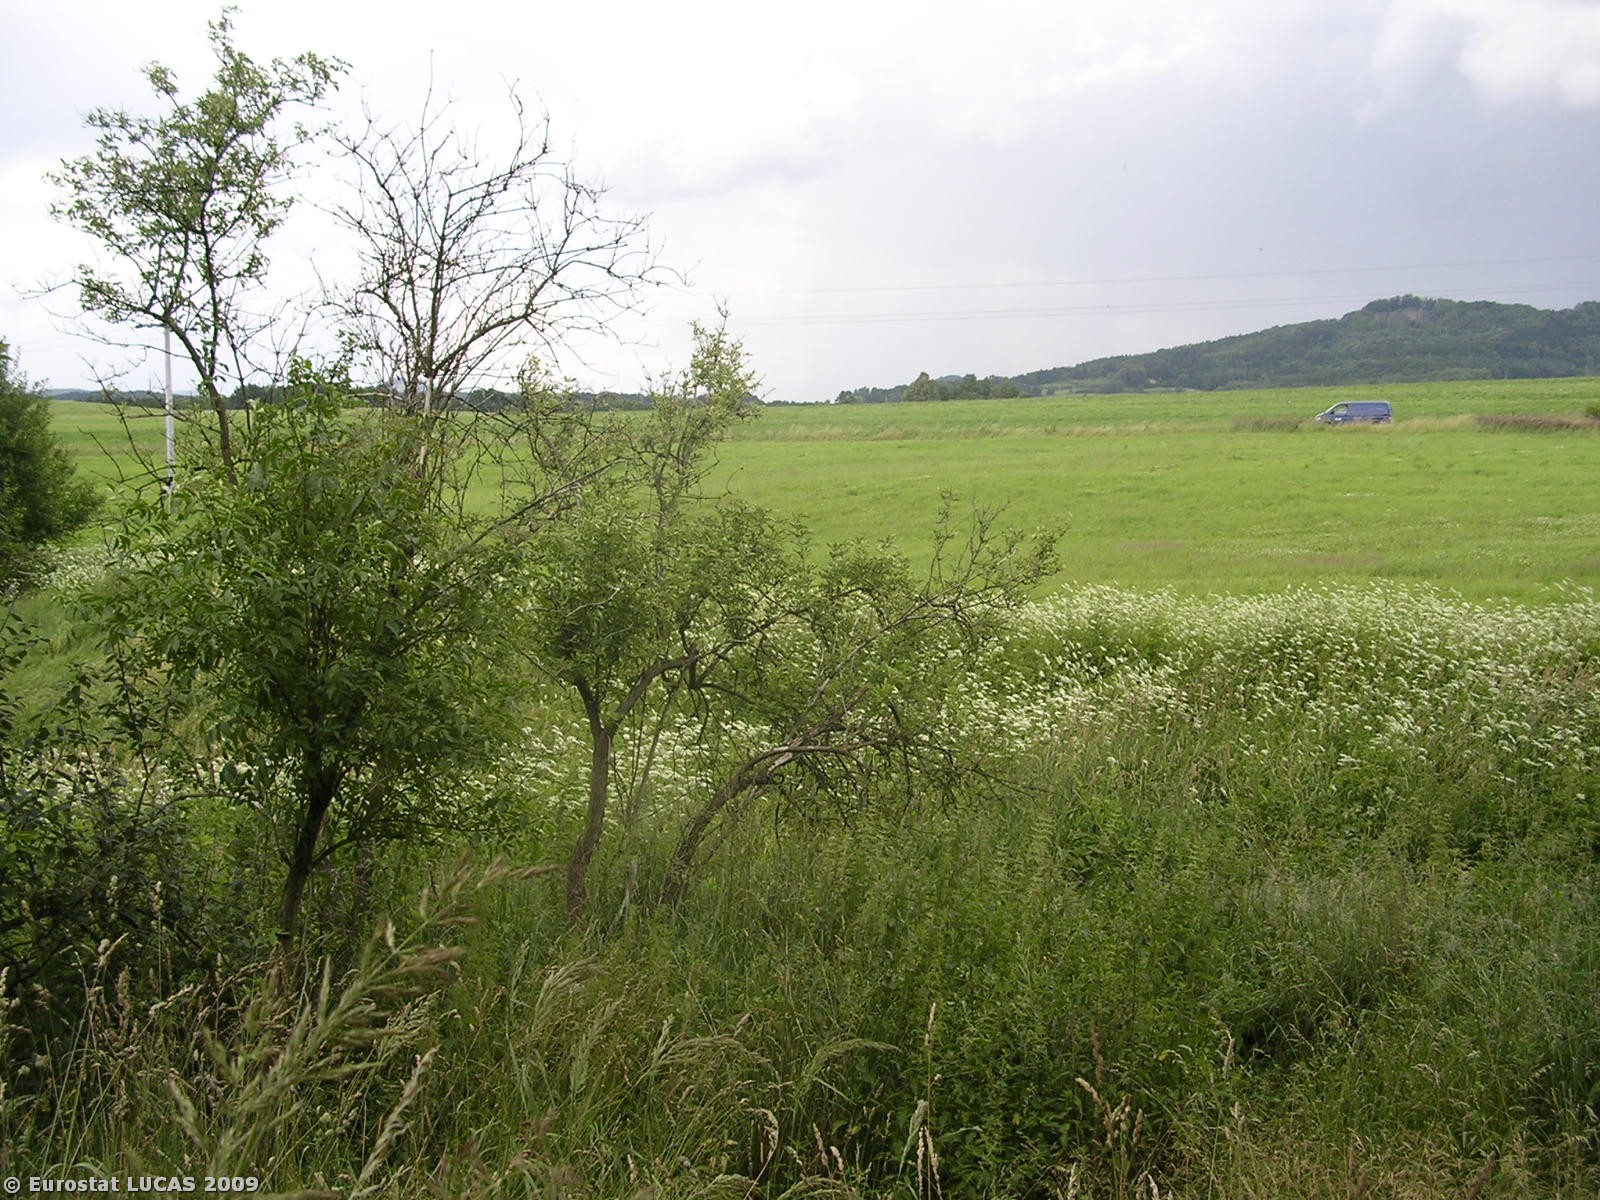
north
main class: Woodland
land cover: Broadleaved woodland
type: acidophilous oak and oak-birch forest
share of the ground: 50 - 75 %
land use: Forestry
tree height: > 5 m
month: July
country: CZ
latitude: 50.6655
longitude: 14.6568
